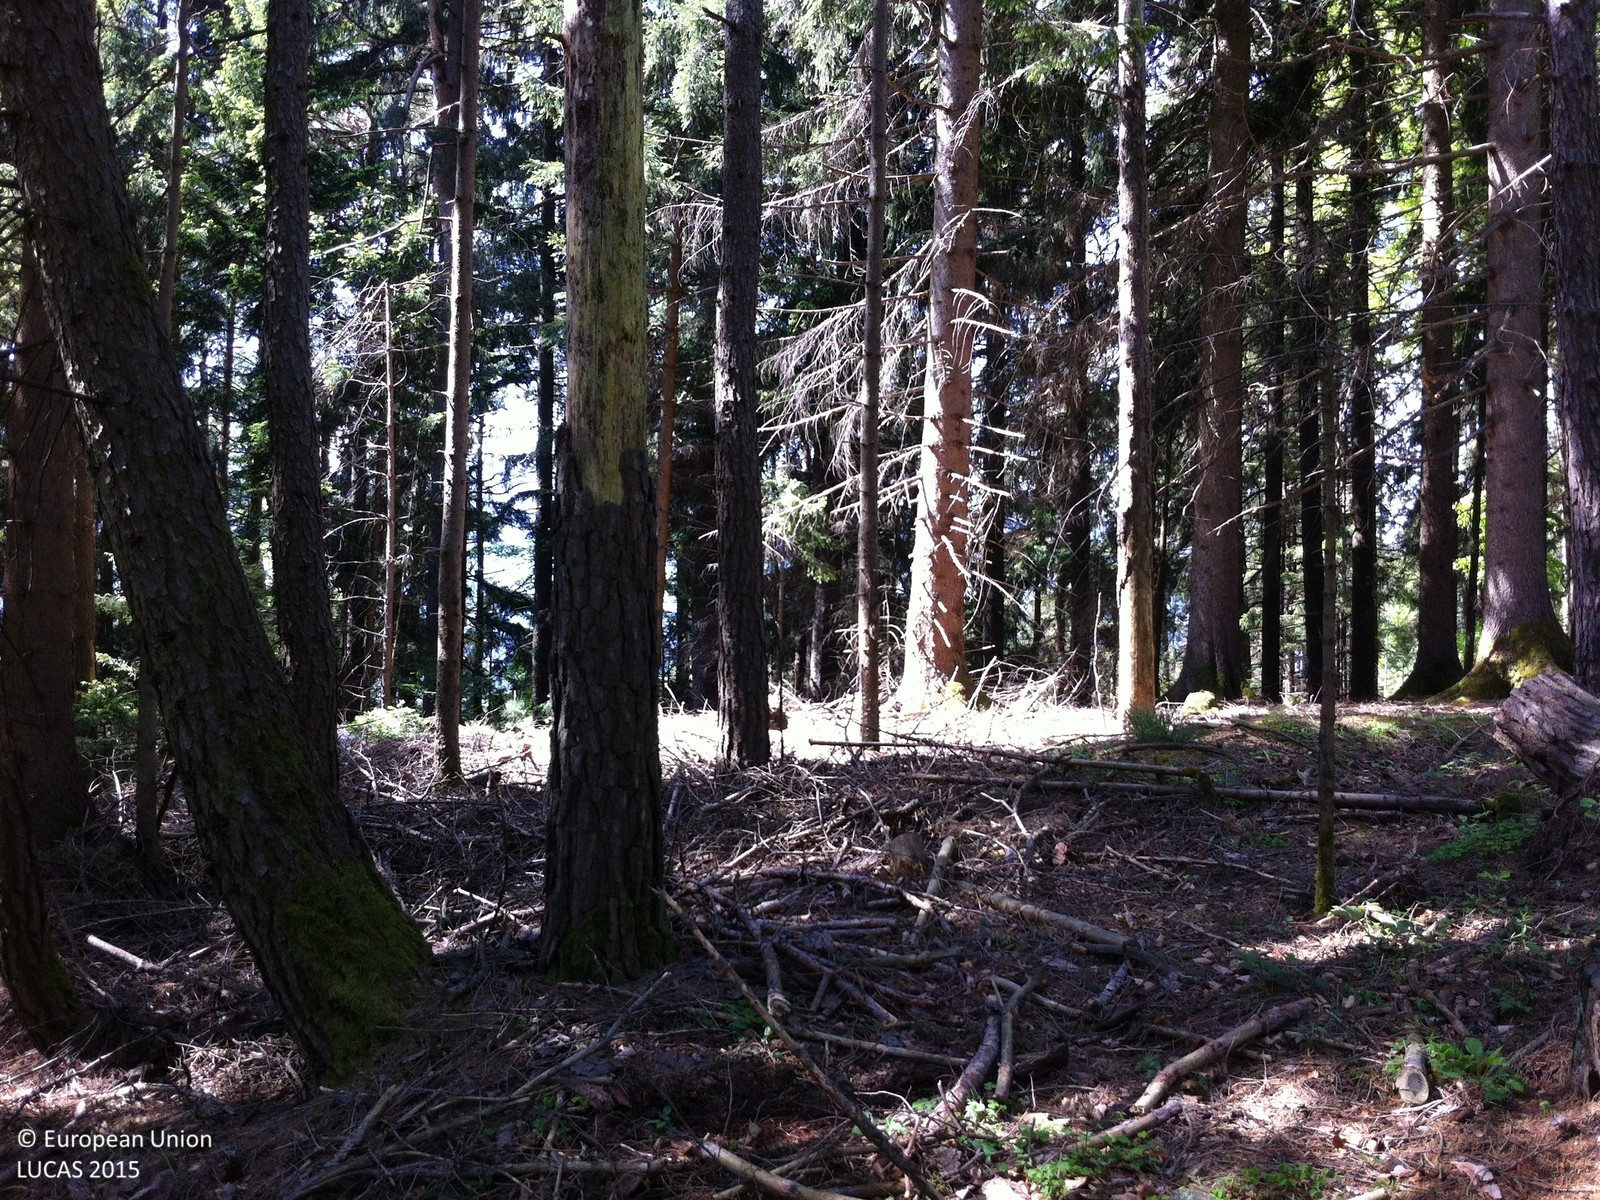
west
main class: Woodland
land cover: Spruce dominated coniferous woodland
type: alpine coniferous forest
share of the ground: > 75 %
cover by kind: coniferous forest trees 100 %
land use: Forestry
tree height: > 5 m
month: May
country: AT
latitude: 47.3466
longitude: 11.6797
